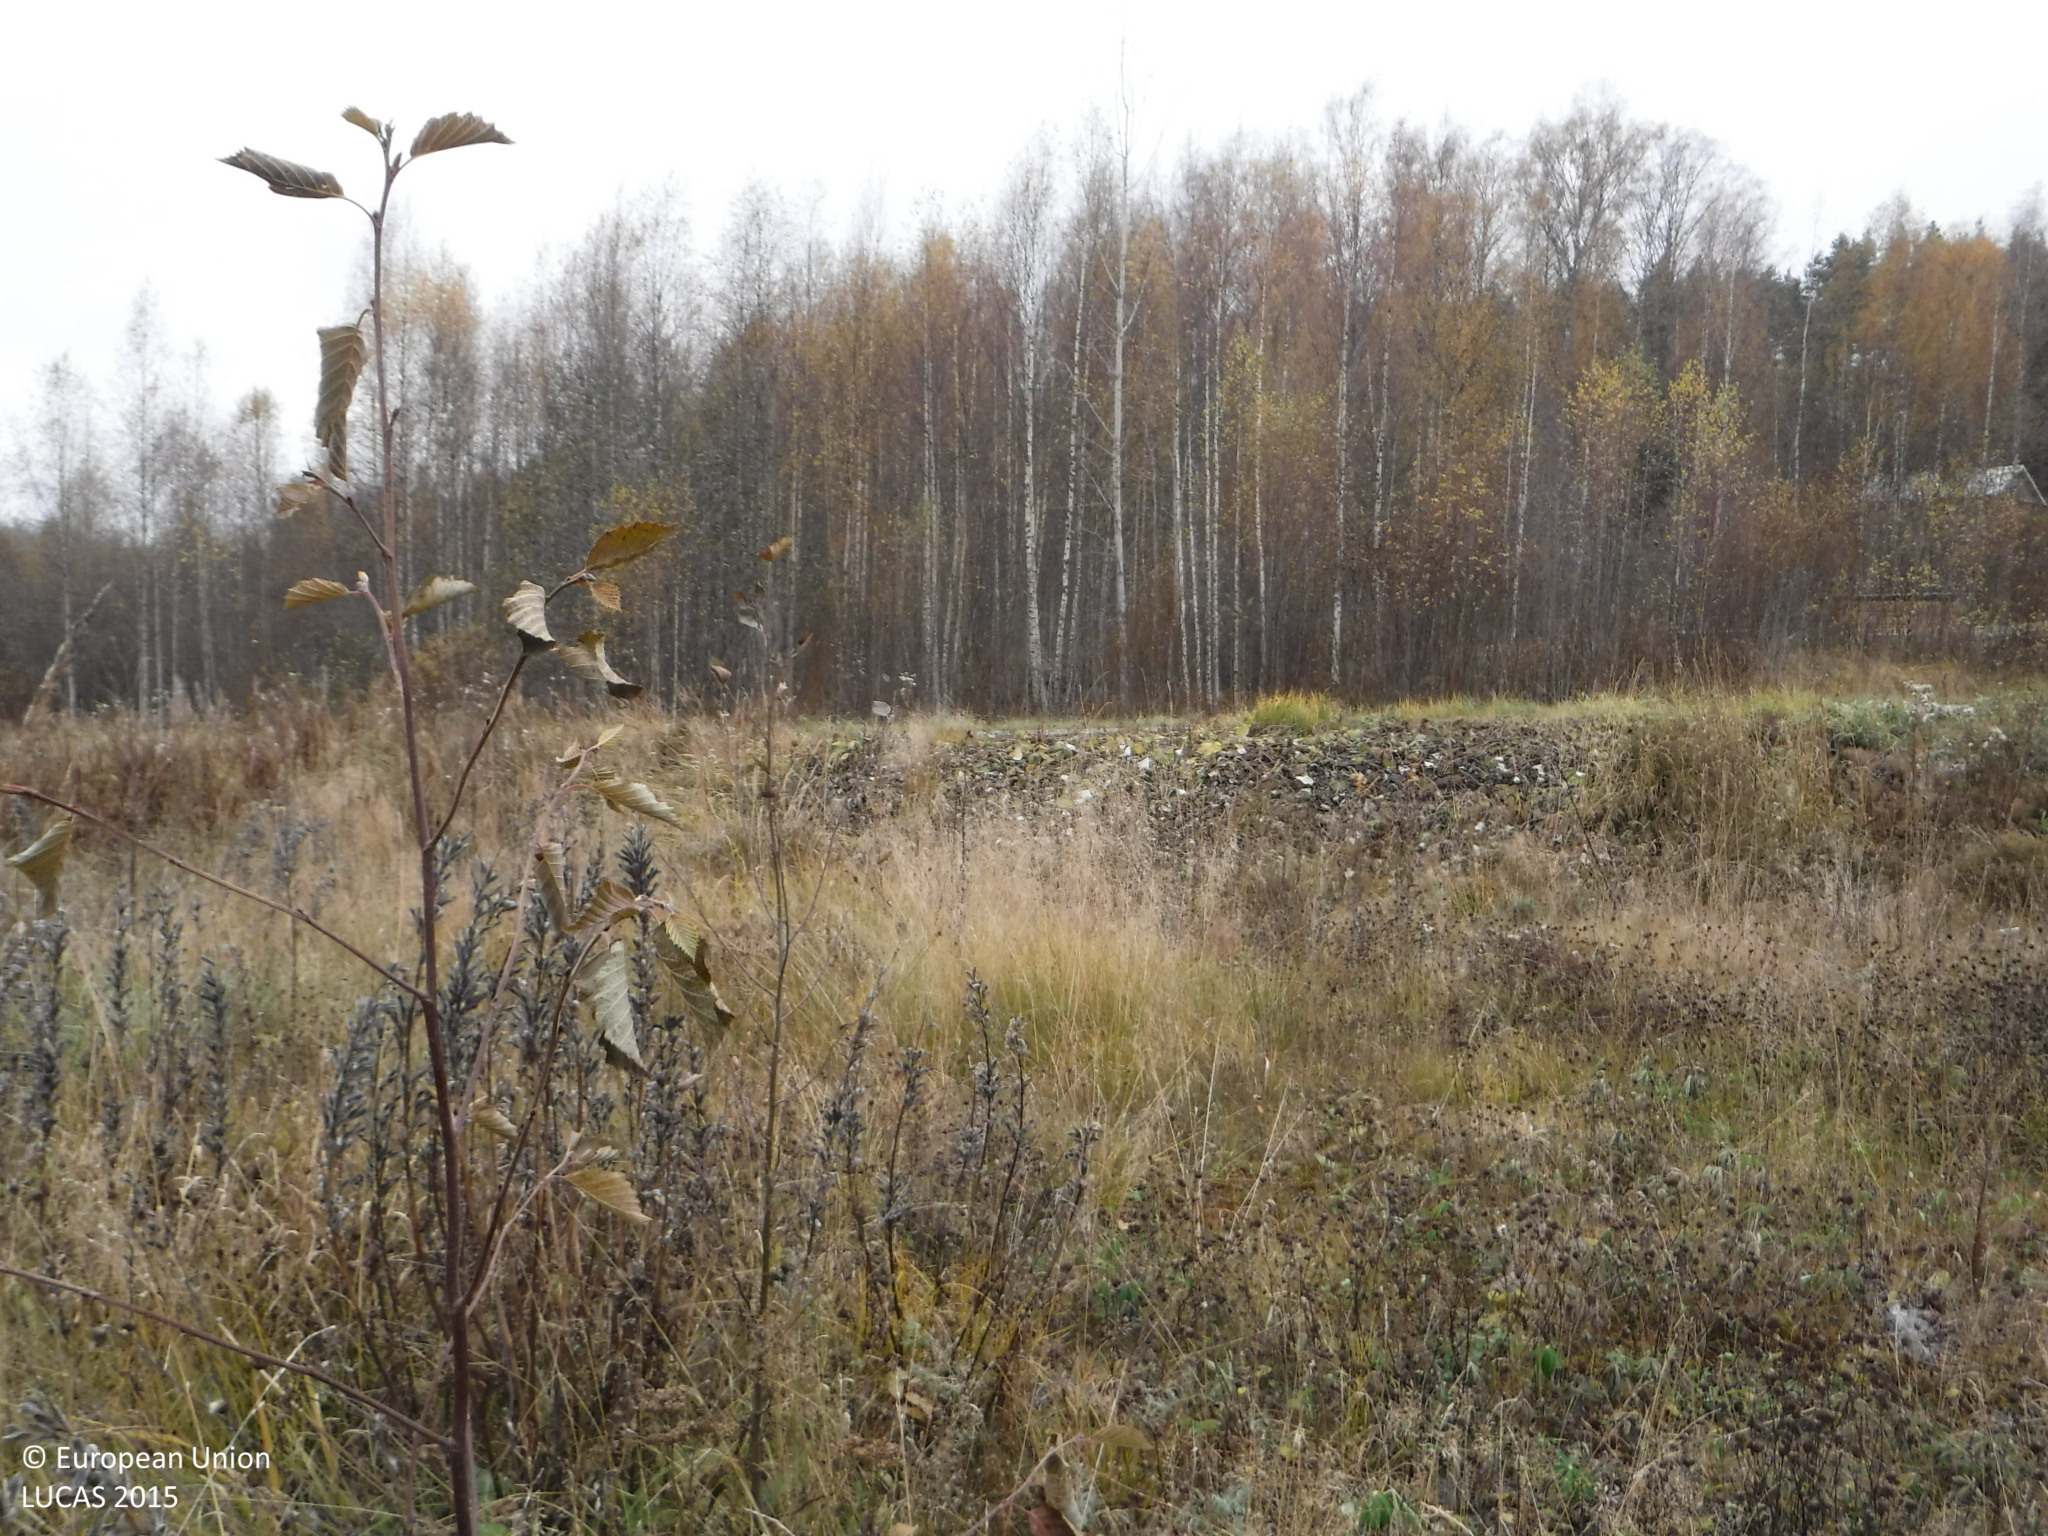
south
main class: Grassland
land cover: Spontaneously vegetated surfaces
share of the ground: > 75 %
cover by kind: herbaceous plants 100 %
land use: Road transport
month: October
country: FI
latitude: 62.0766
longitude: 26.0362
